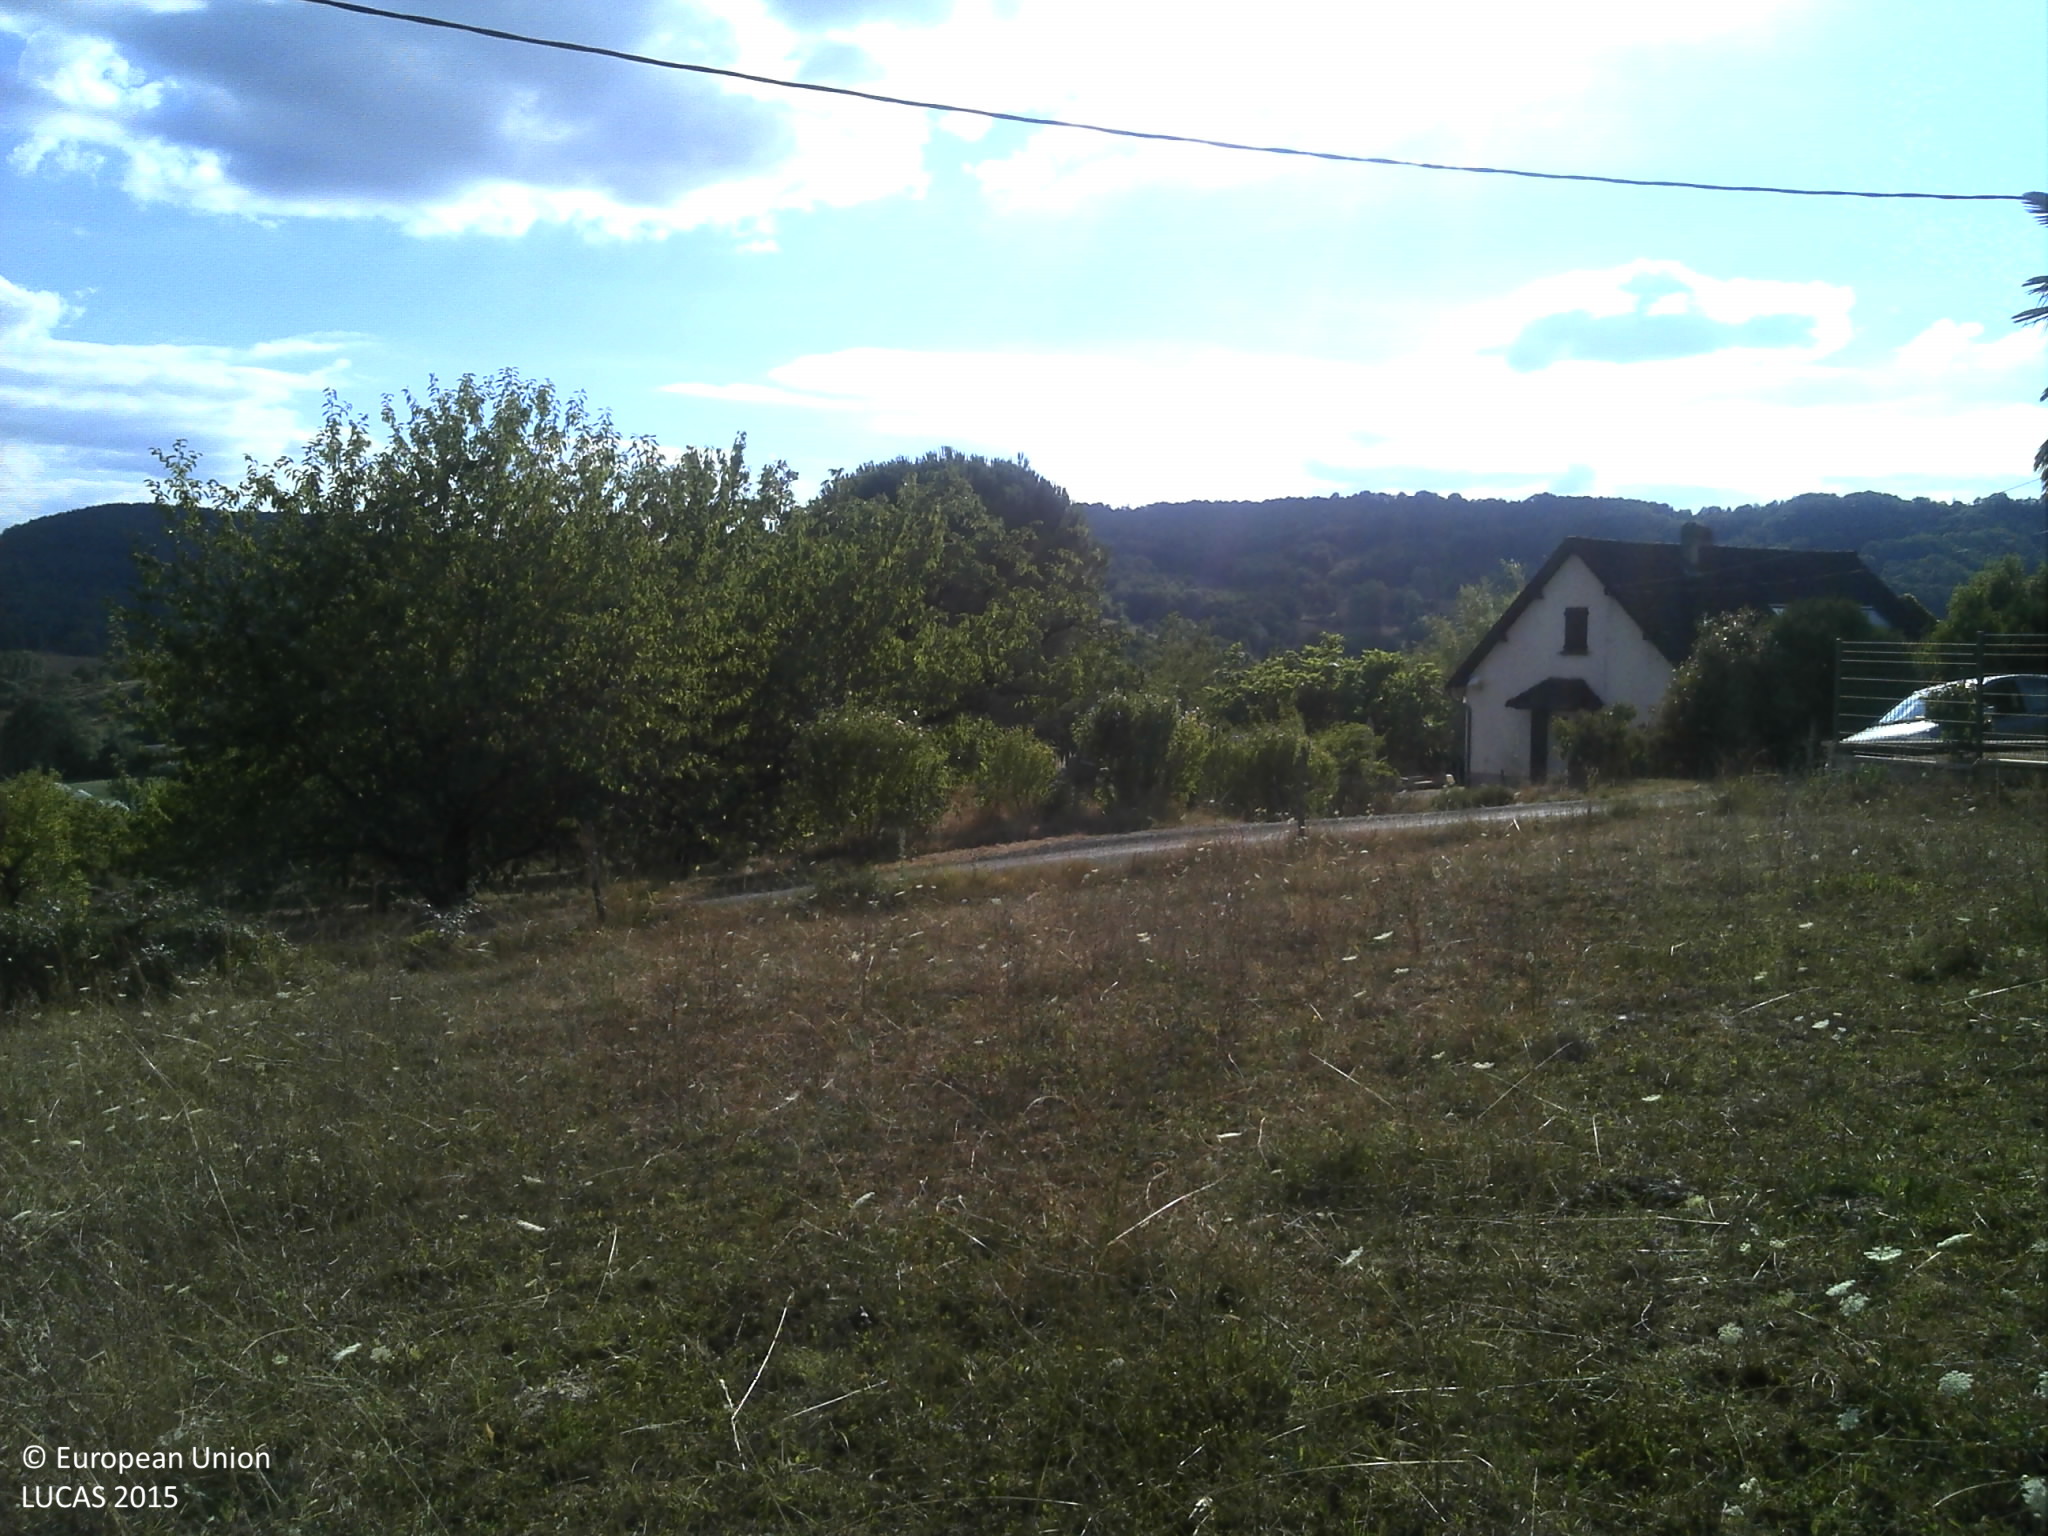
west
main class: Grassland
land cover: Grassland without tree/shrub cover
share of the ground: > 75 %
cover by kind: herbaceous plants 100 %
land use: Agriculture (excluding fallow land and kitchen gardens)
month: July
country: FR
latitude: 45.0230
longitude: 1.8117
